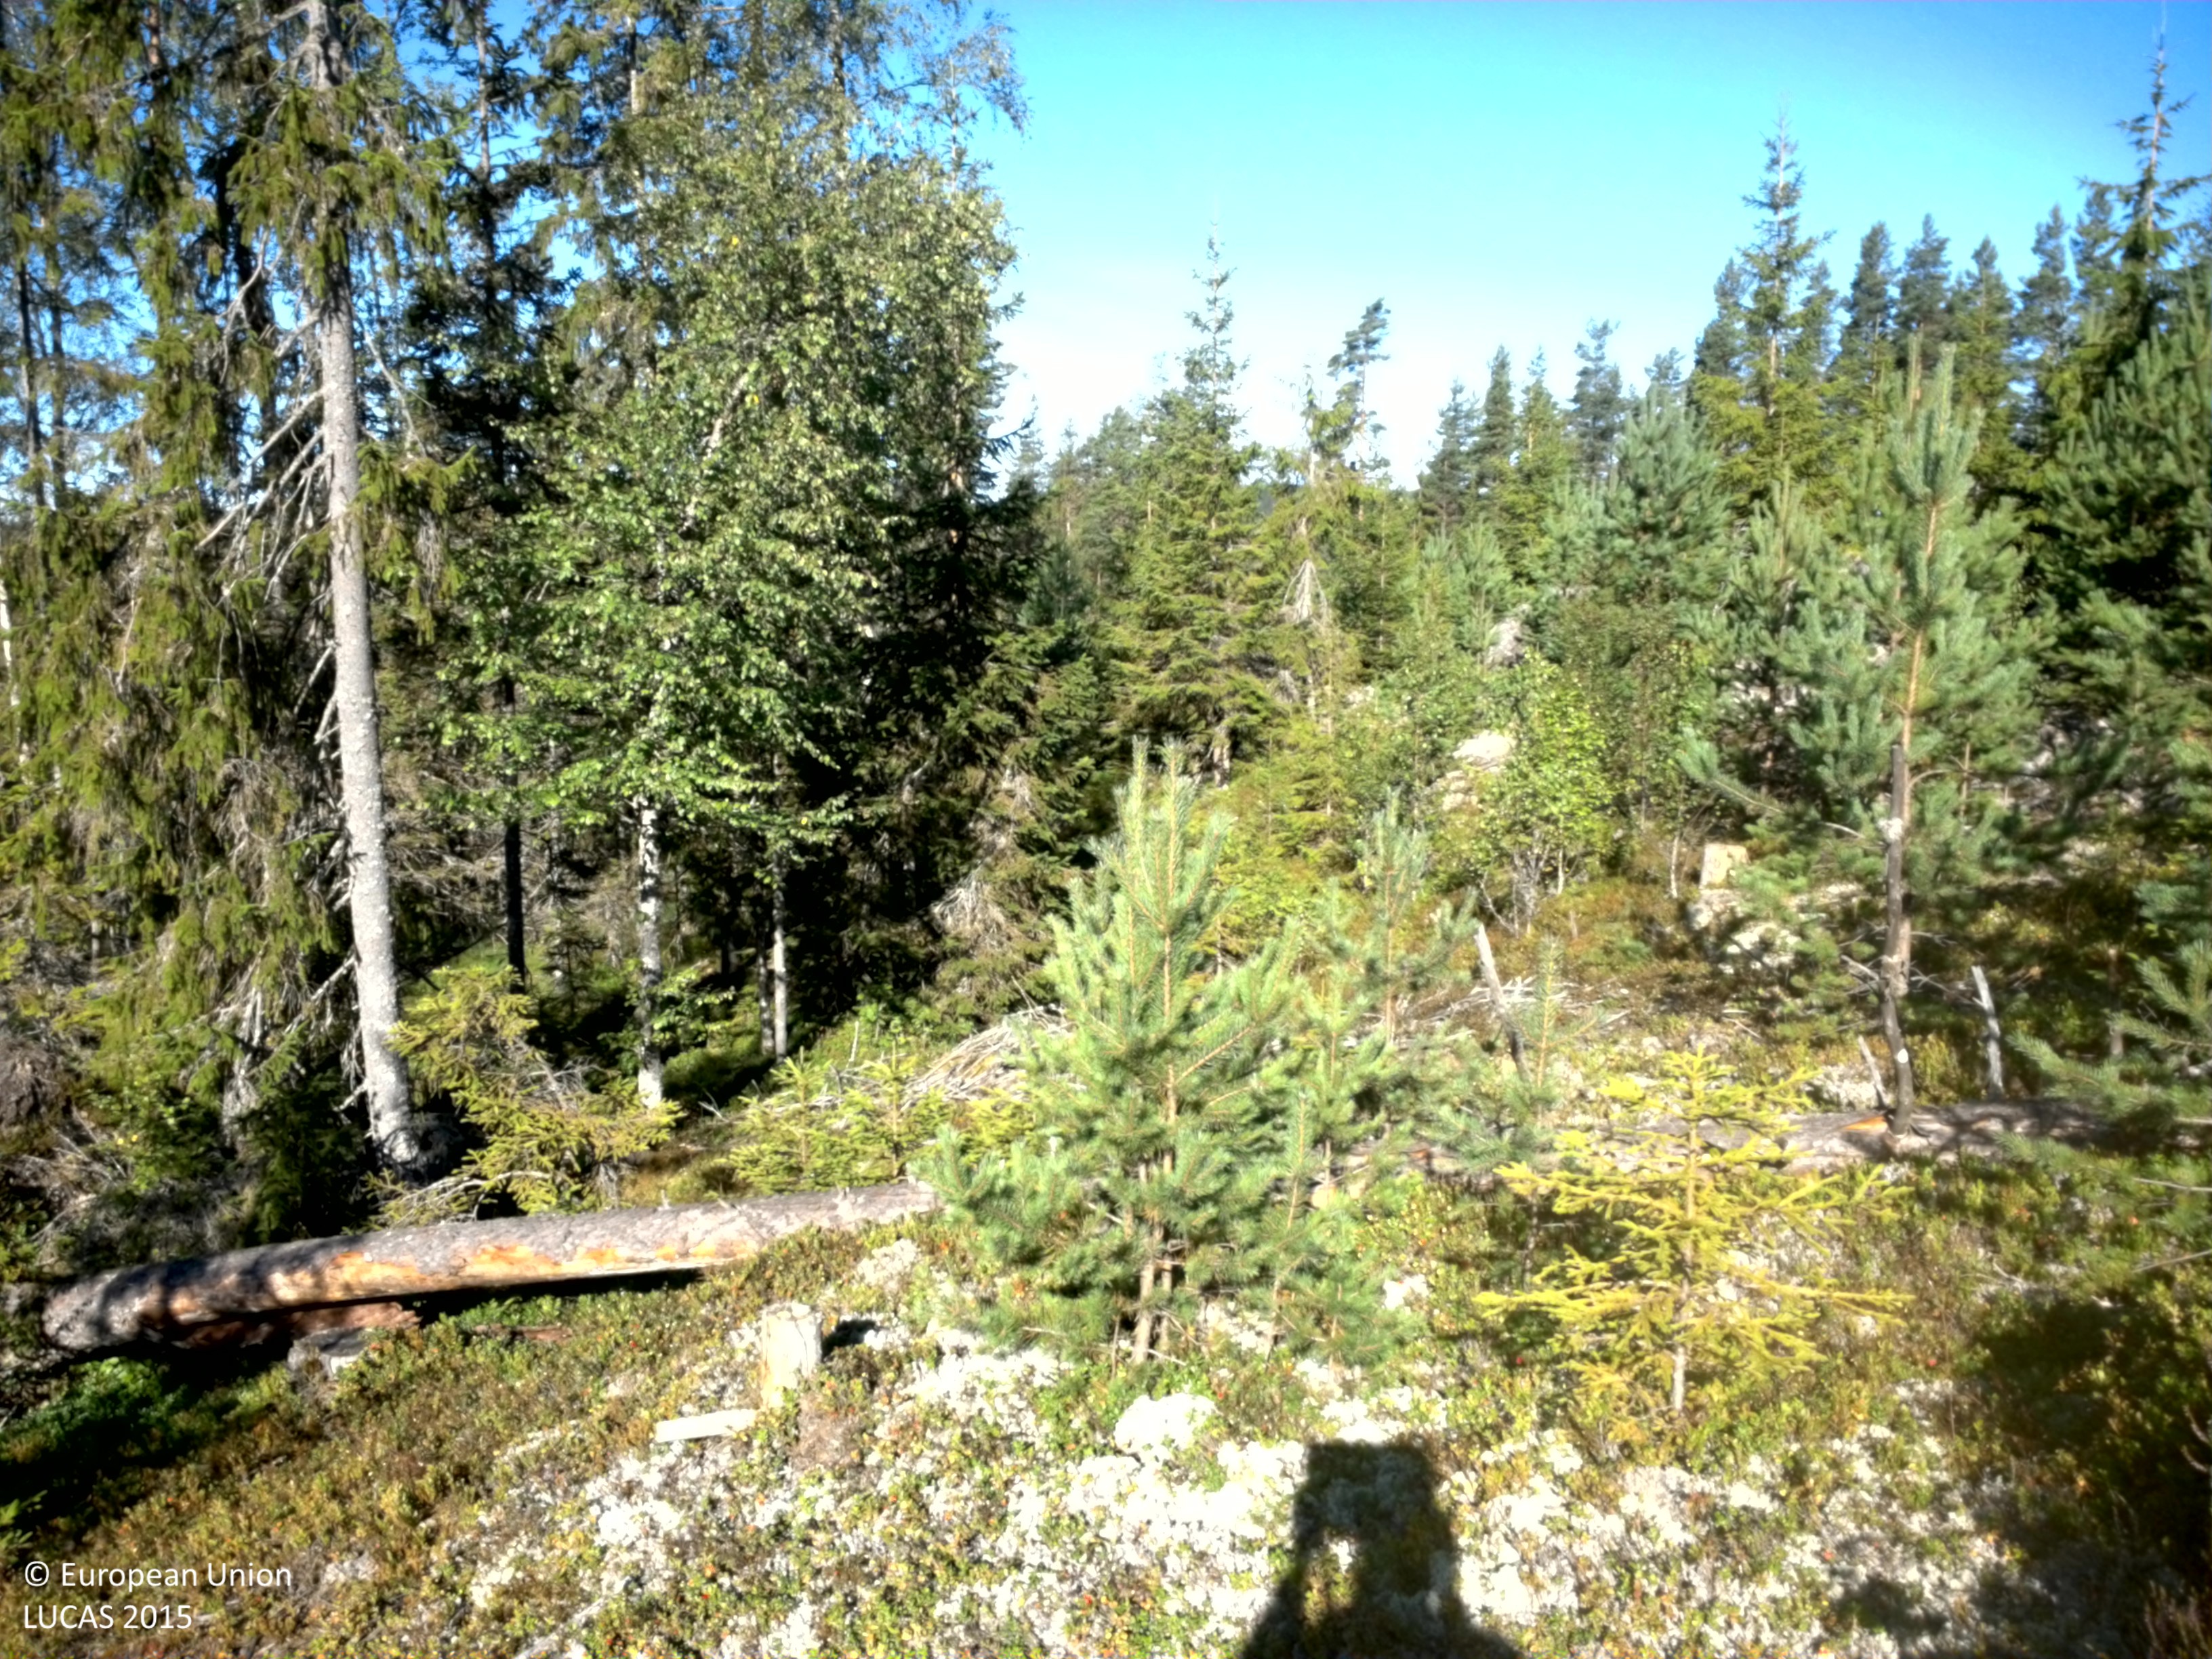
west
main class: Woodland
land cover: Other mixed woodland
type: boreal forest
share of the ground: 50 - 75 %
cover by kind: coniferous forest trees 40 %, broadleaved forest trees 25 %, shrubs 25 %, lichens and mosses 10 %
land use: Forestry
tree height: < 5 m
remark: Clear cut
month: August
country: SE
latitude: 60.0310
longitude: 14.0998
